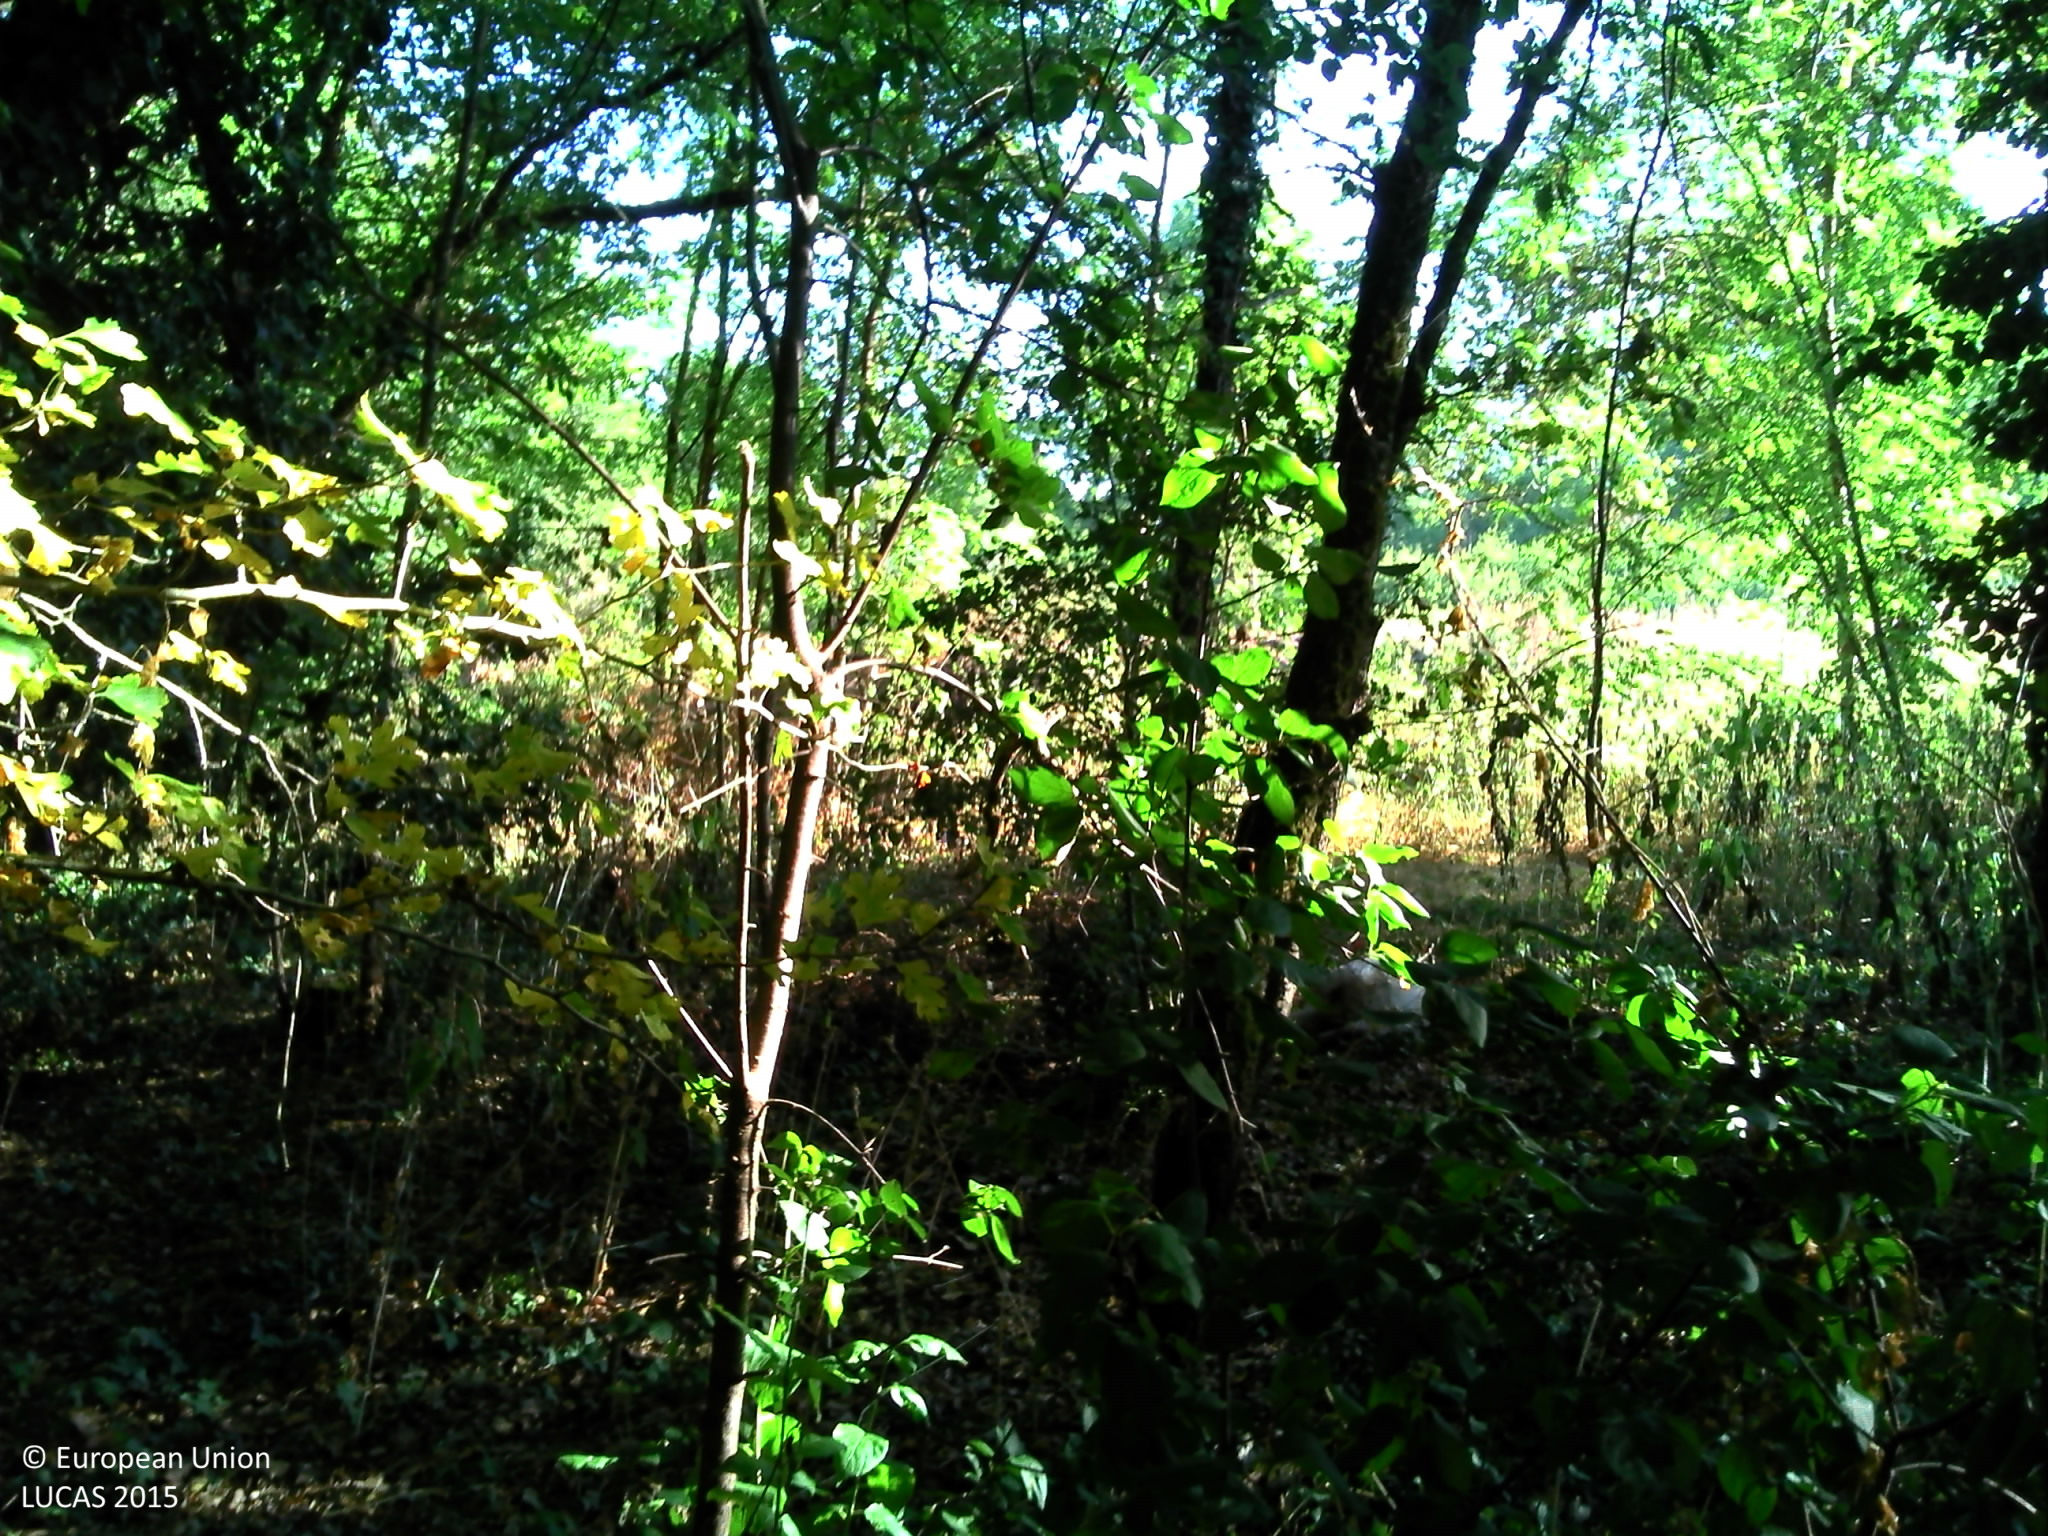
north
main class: Woodland
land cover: Broadleaved woodland
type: acidophilous oak and oak-birch forest
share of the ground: > 75 %
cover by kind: broadleaved forest trees 80 %, herbaceous plants 10 %, shrubs 5 %, lichens and mosses 5 %
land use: Forestry
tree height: > 5 m
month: July
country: FR
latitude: 44.7202
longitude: 0.5863
